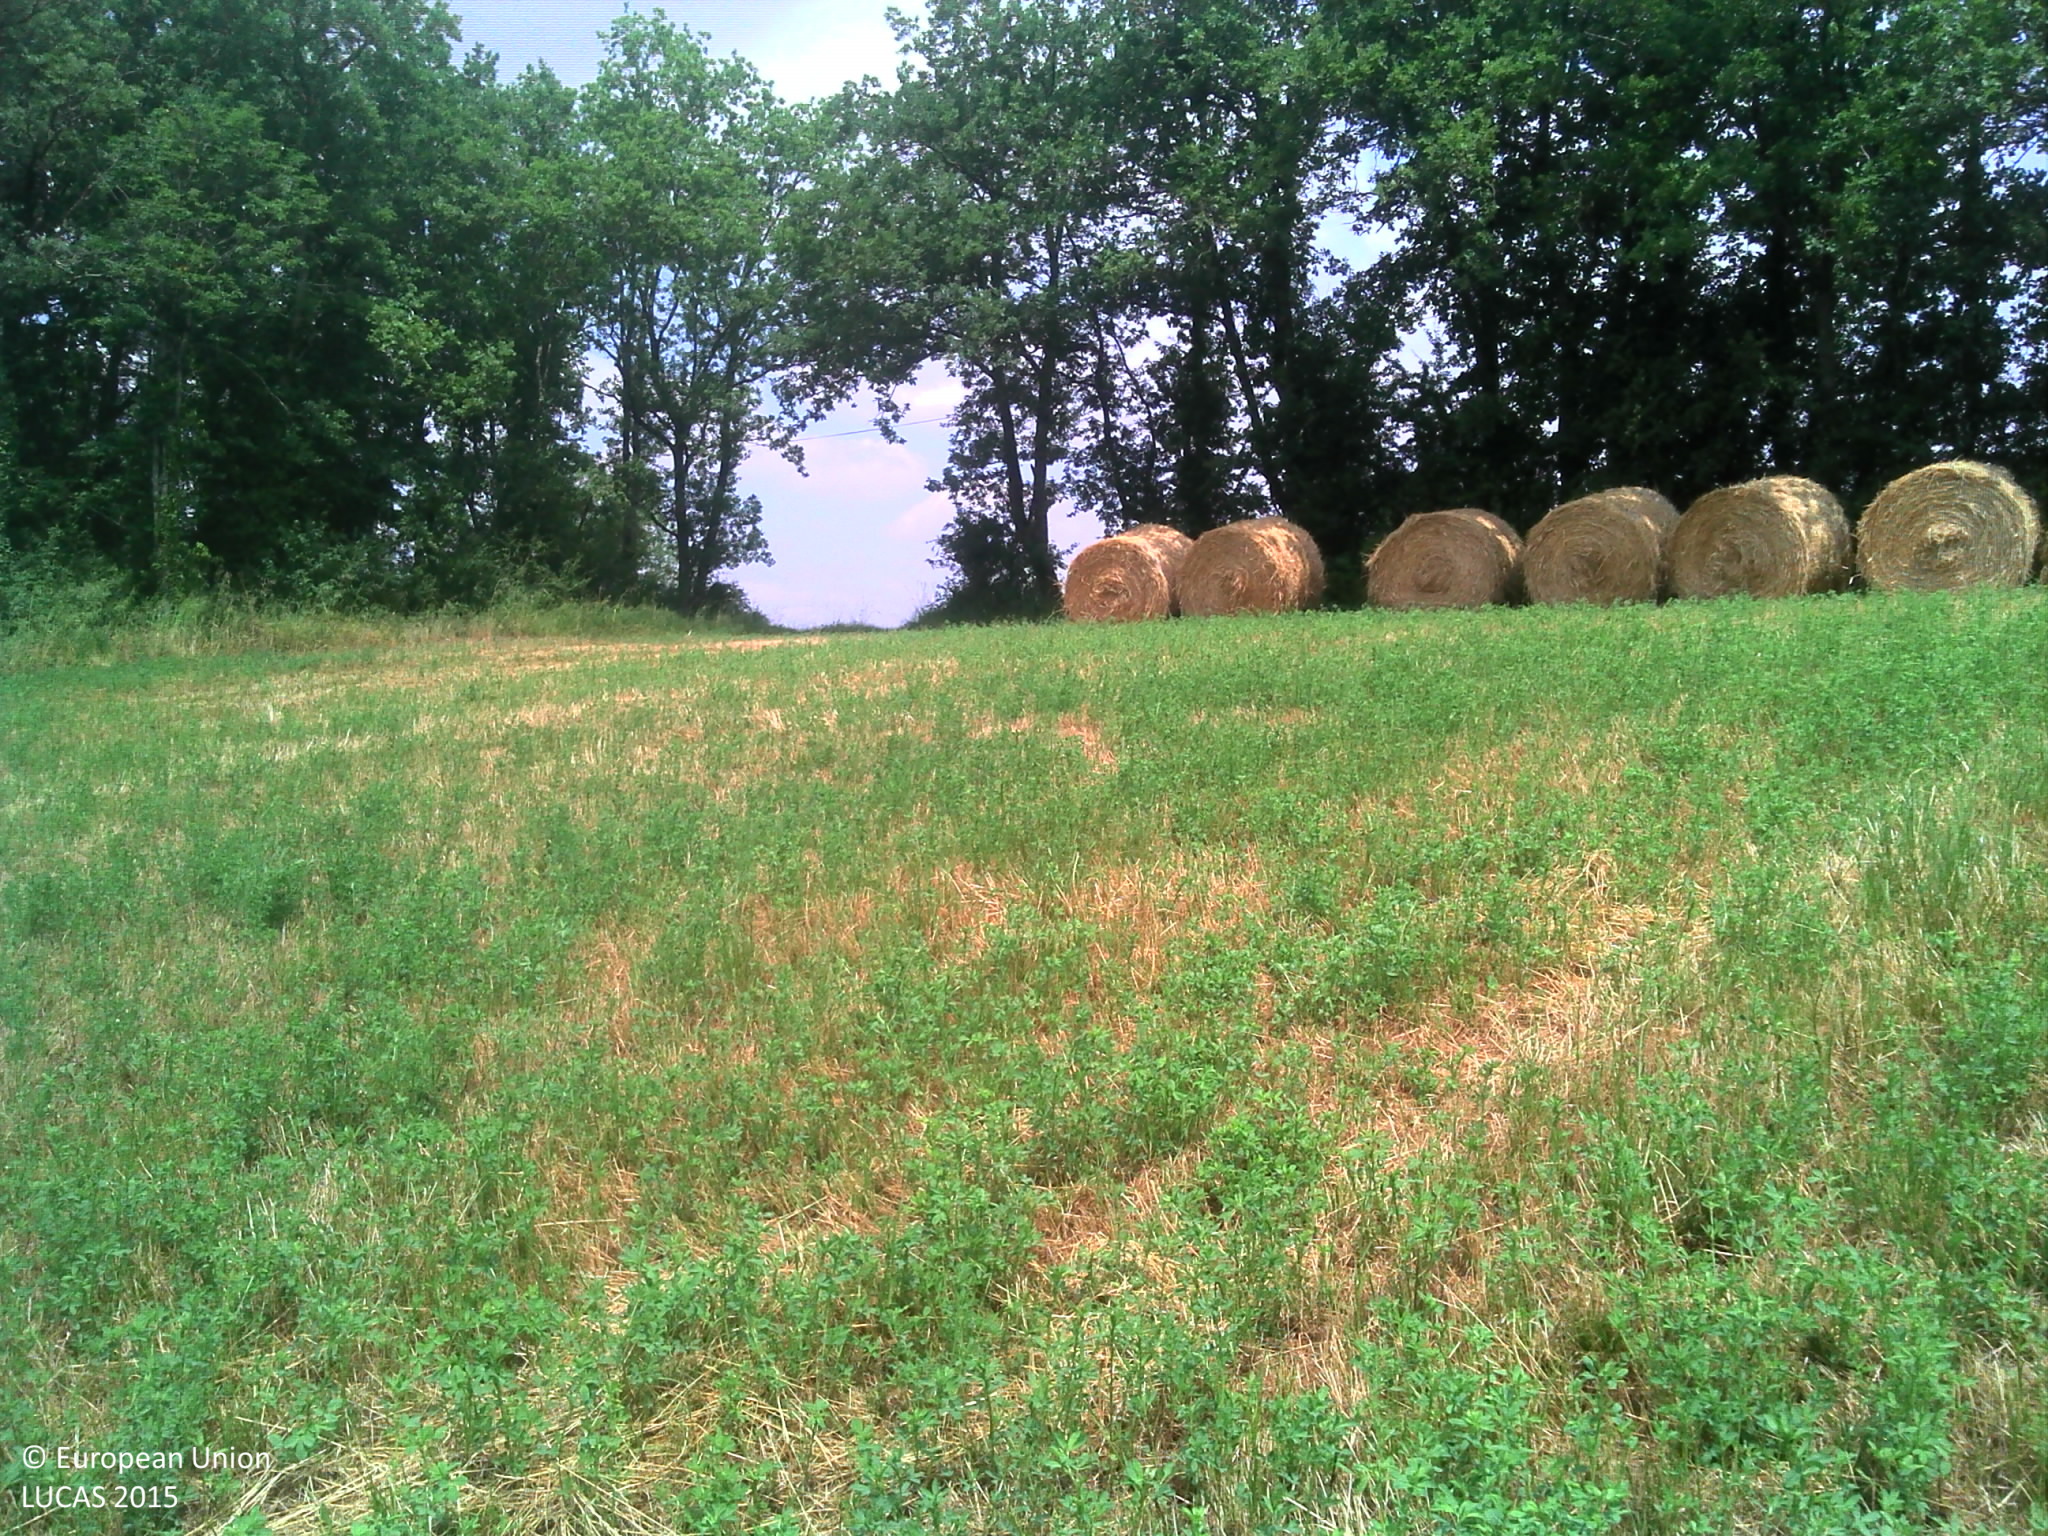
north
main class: Cropland
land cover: Lucerne
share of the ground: > 75 %
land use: Agriculture (excluding fallow land and kitchen gardens)
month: June
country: FR
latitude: 43.7605
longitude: 2.1172
